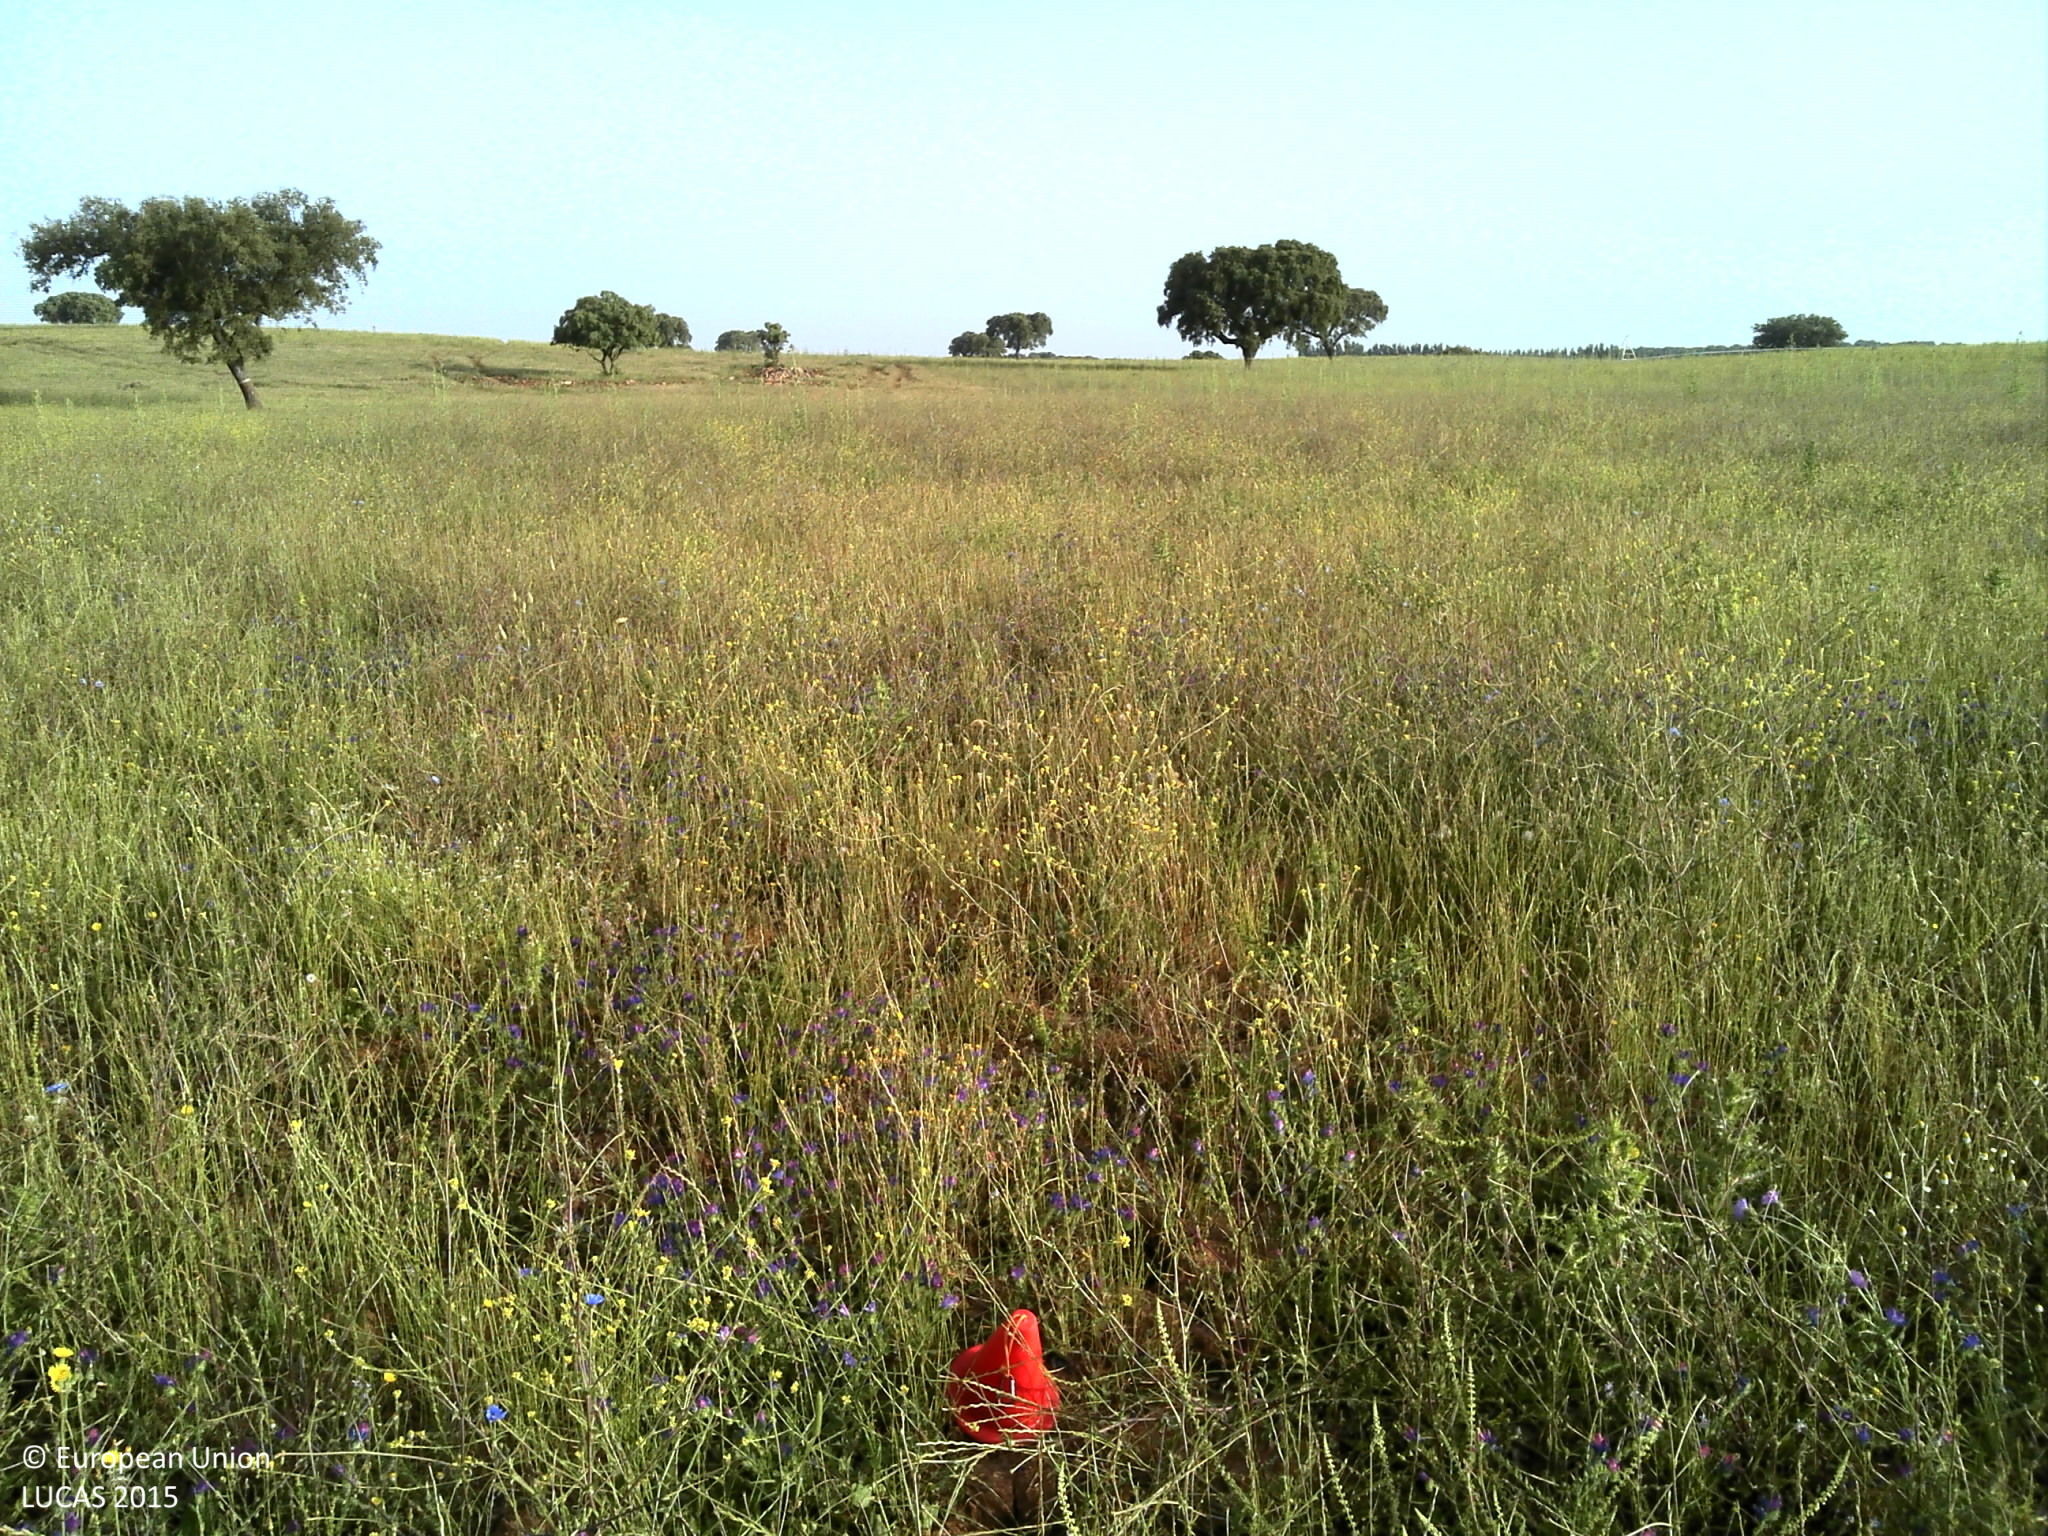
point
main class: Grassland
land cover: Grassland without tree/shrub cover
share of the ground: 50 - 75 %
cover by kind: herbaceous plants 75 %, unconsolidated bare surface 25 %
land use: Agriculture (excluding fallow land and kitchen gardens)
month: May
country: PT
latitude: 39.0360
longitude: -7.8730
